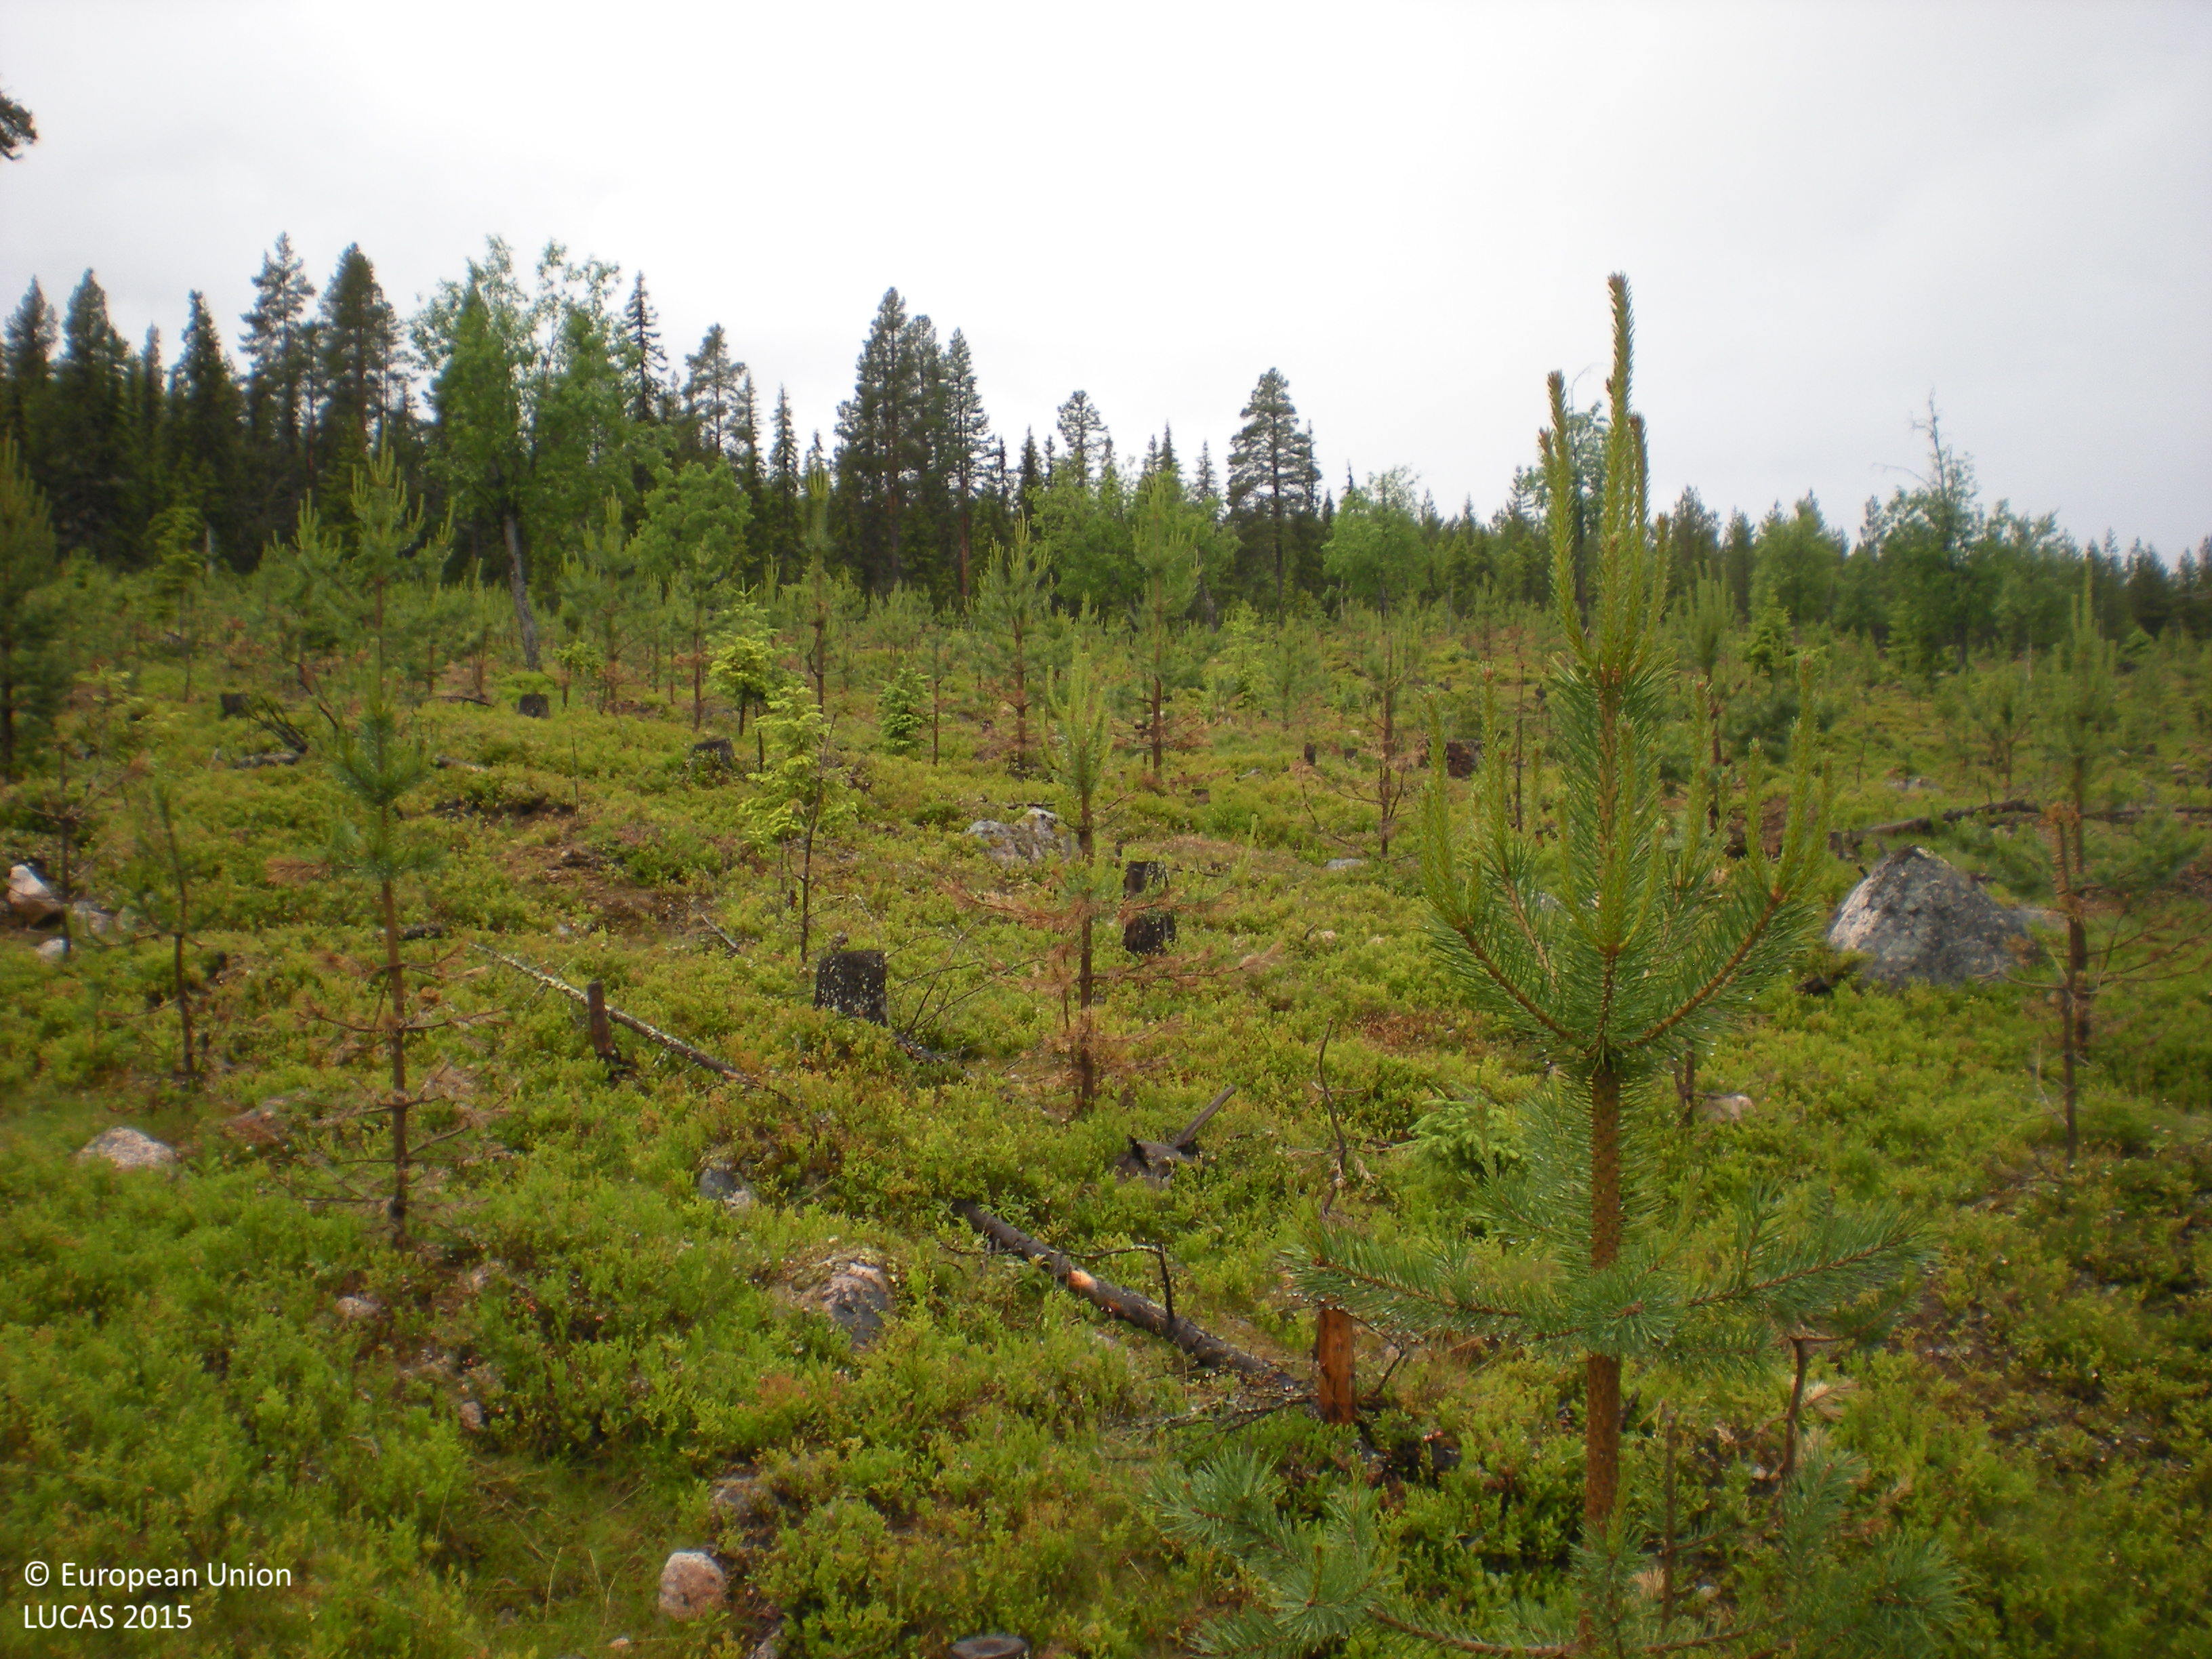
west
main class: Woodland
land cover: Pine dominated coniferous woodland
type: boreal forest
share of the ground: 25 - 50 %
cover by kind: shrubs 55 %, coniferous forest trees 30 %, lichens and mosses 10 %, herbaceous plants 5 %
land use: Forestry
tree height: < 5 m
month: July
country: SE
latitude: 65.8449
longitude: 17.7316
